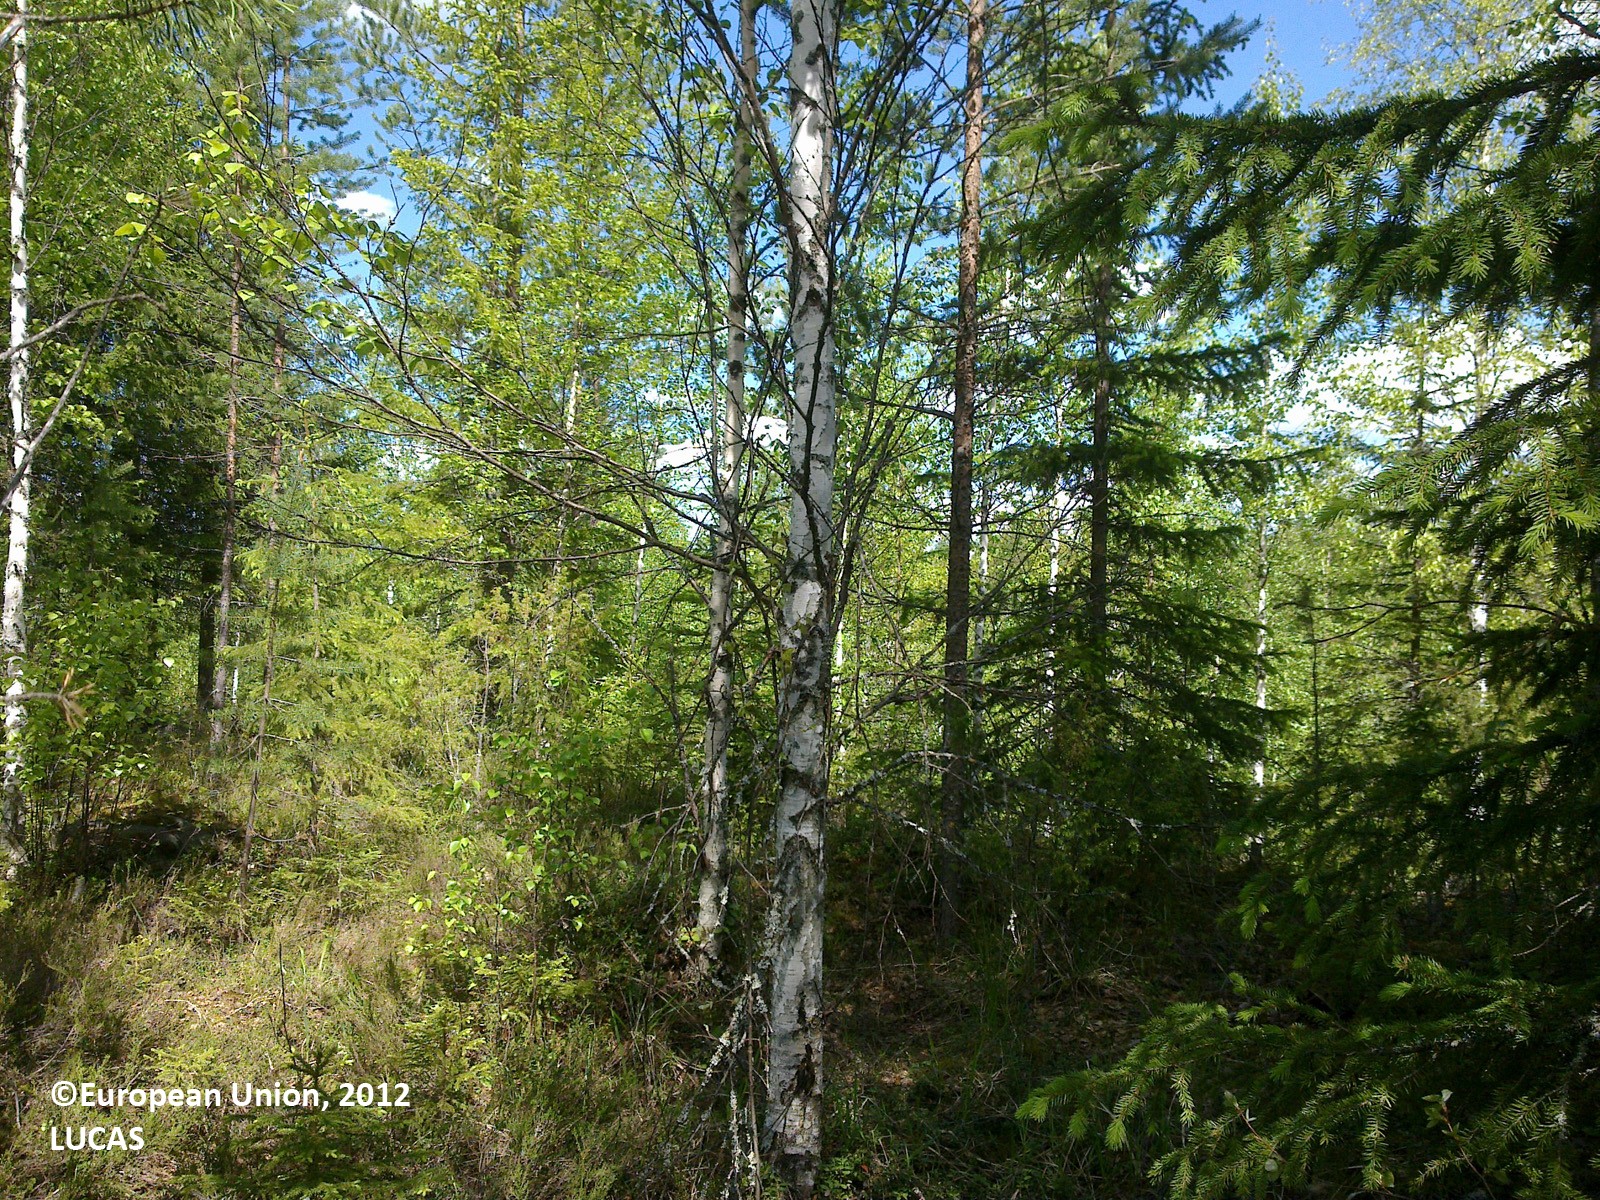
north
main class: Woodland
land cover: Other mixed woodland
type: boreal forest
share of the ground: > 75 %
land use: Forestry
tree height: > 5 m
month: June
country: FI
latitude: 62.5762
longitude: 30.5437
